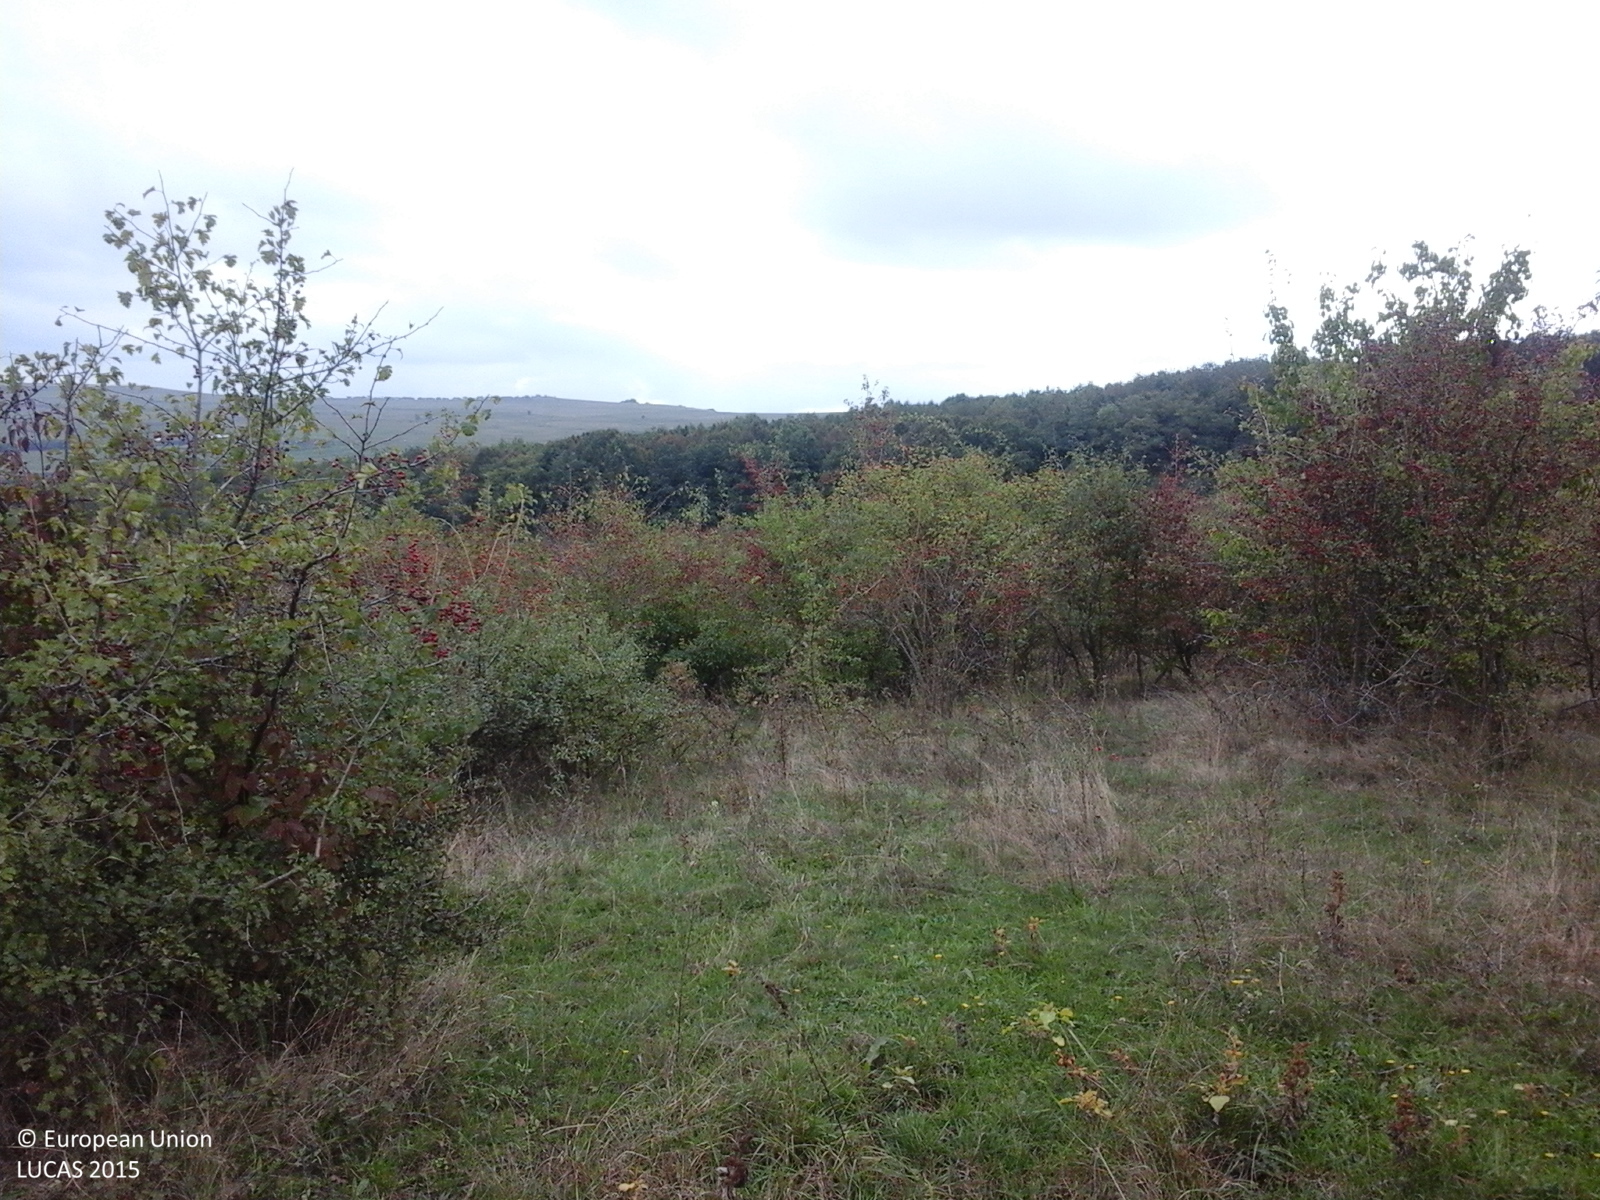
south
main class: Grassland
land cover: Grassland with sparse tree/shrub cover
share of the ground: > 75 %
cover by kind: herbaceous plants 95 %, broadleaved forest trees 5 %
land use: Semi-natural and natural areas not in use
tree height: < 5 m
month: October
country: RO
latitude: 46.3716
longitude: 24.0252
